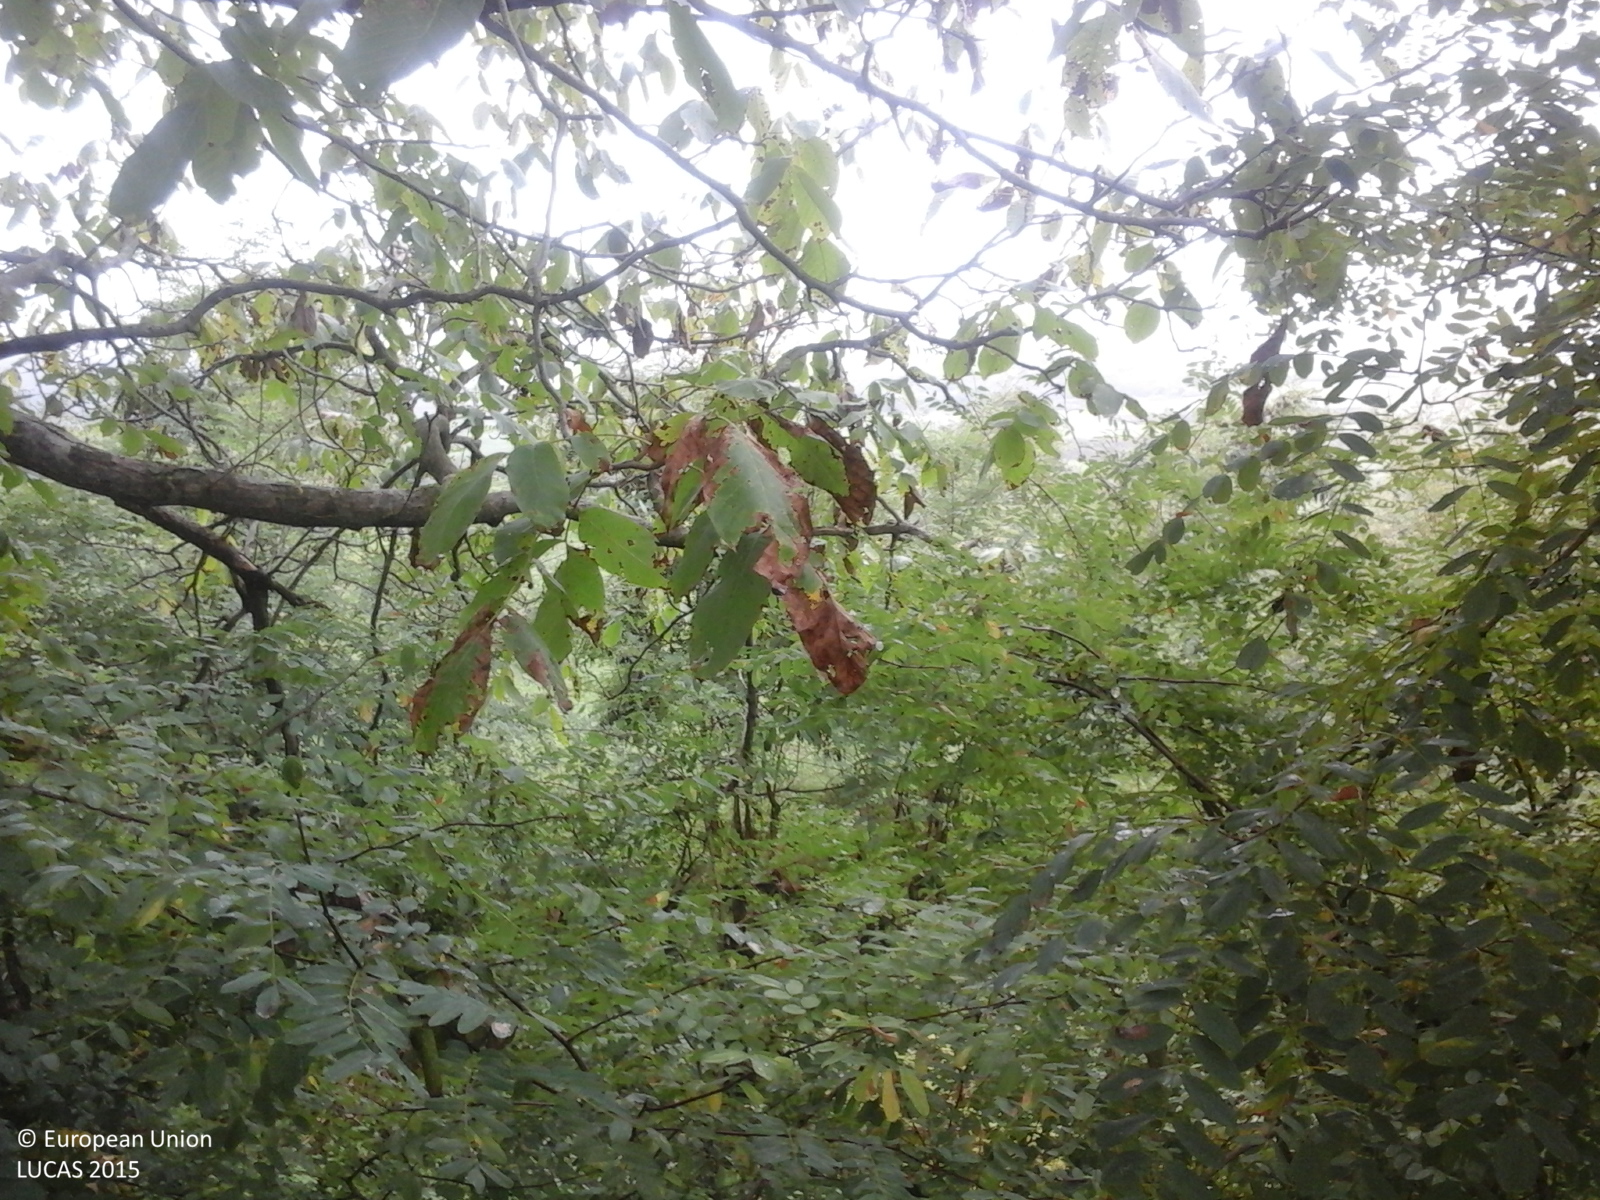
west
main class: Woodland
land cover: Broadleaved woodland
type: broadleaved evergreen forest
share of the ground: > 75 %
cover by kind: broadleaved forest trees 100 %
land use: Forestry
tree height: > 5 m
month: October
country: RO
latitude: 46.1850
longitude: 24.0550
